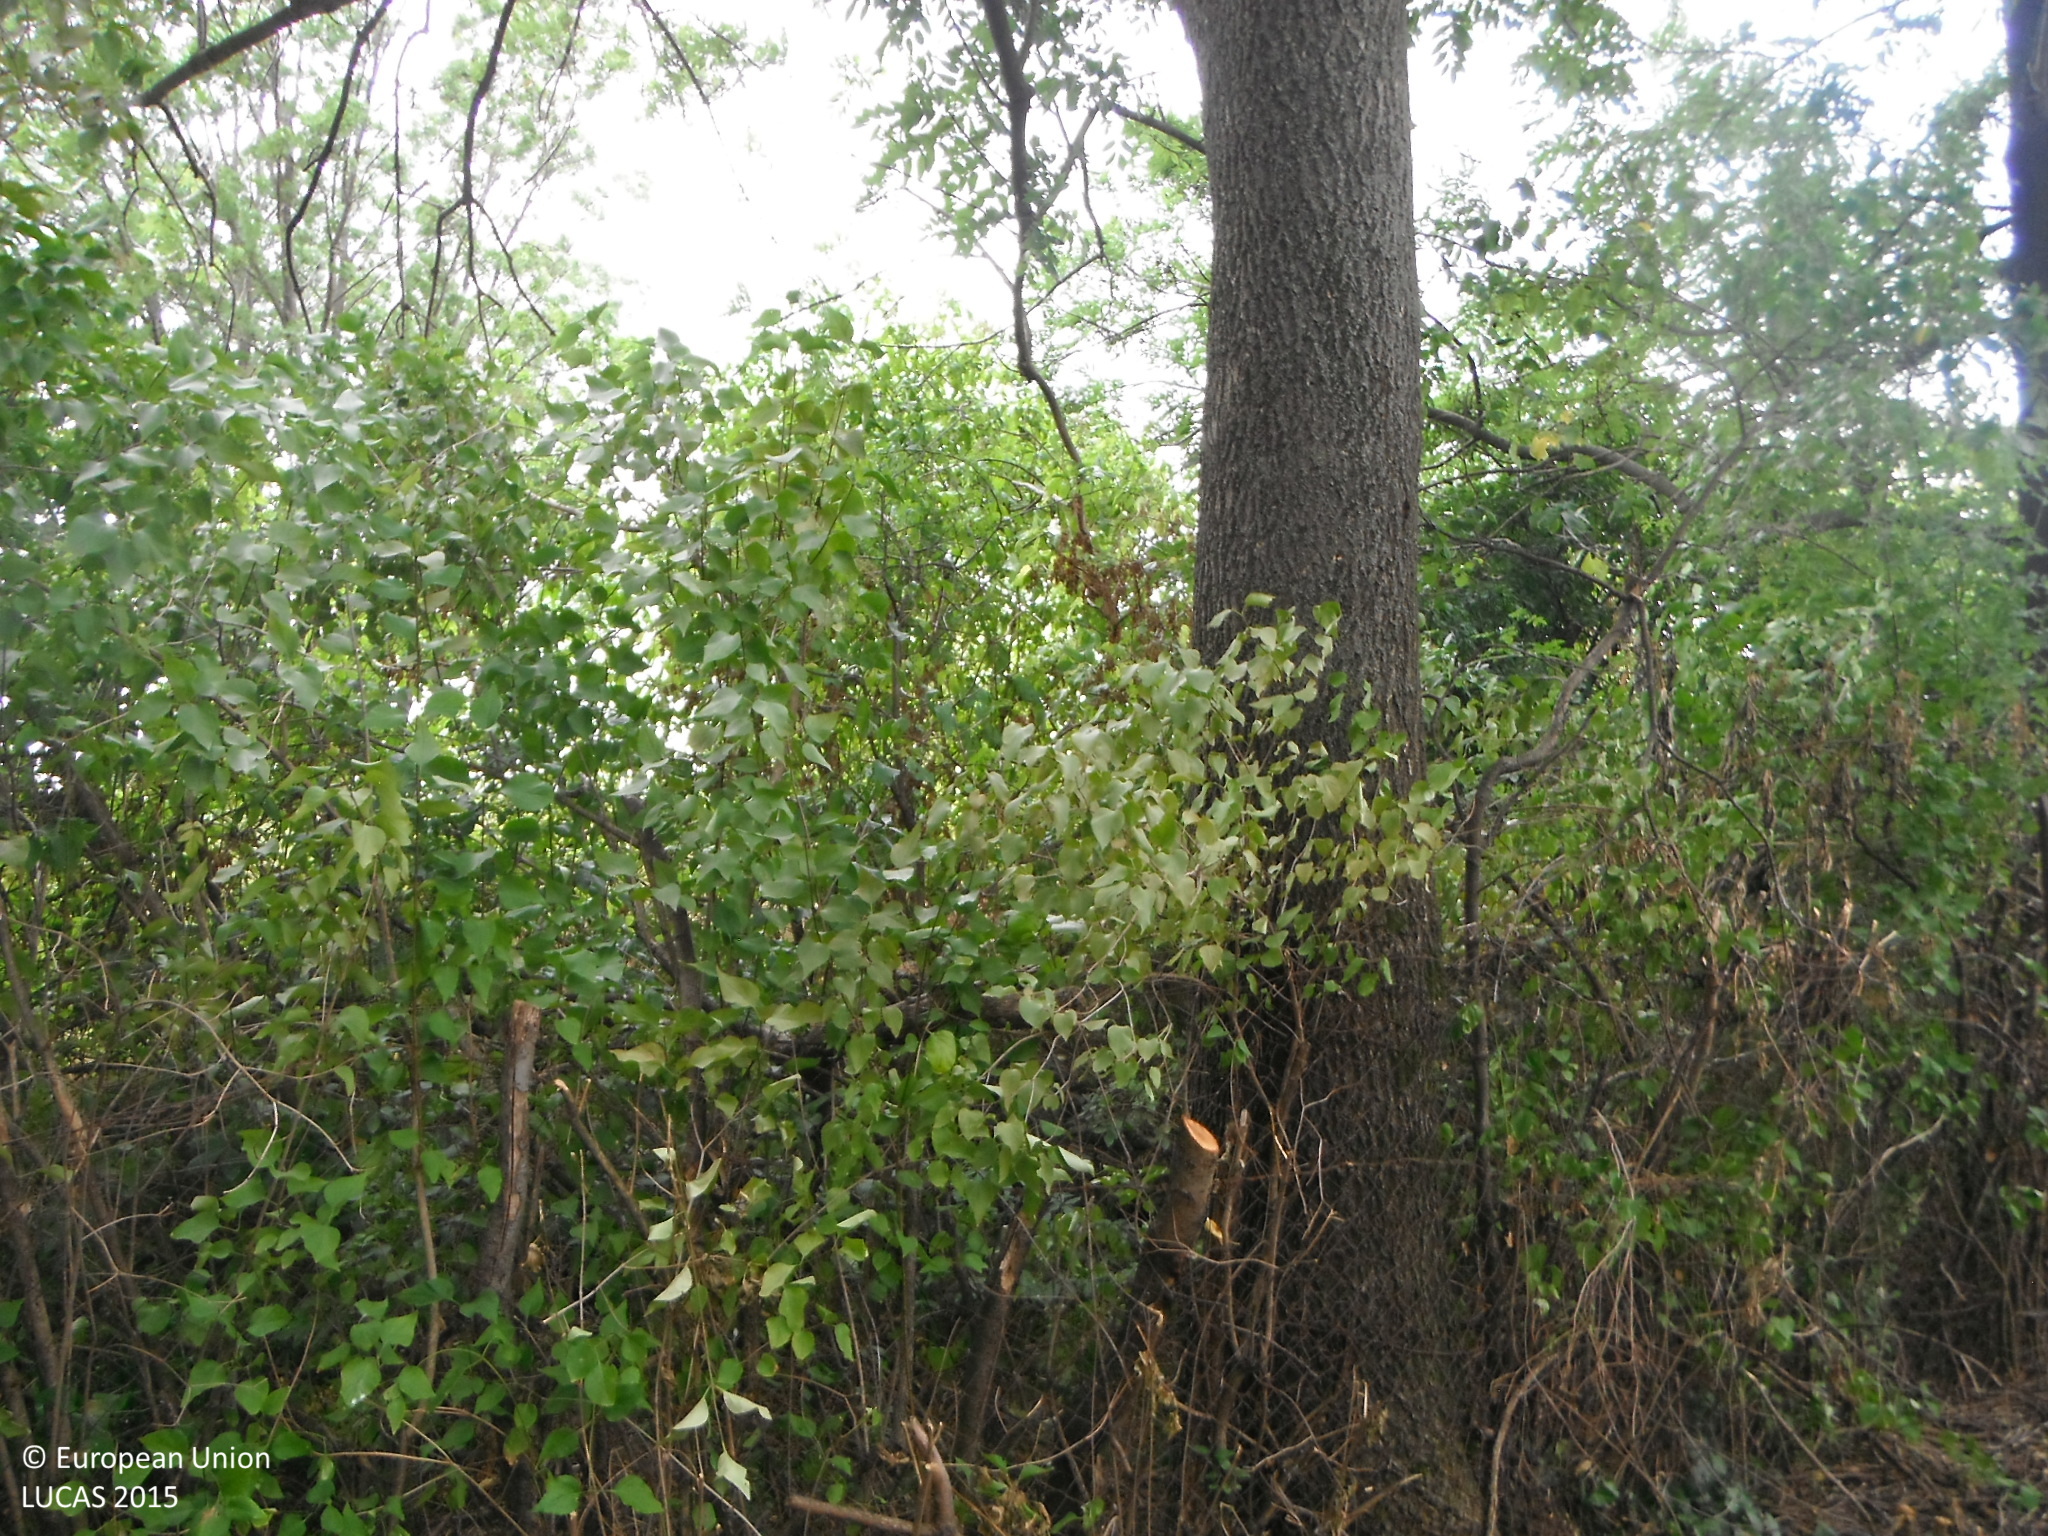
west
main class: Cropland
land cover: Other fruit trees and berries
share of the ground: 10 - 25 %
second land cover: Grassland without tree/shrub cover
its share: > 75 %
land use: Kitchen garden
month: July
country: SK
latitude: 48.4844
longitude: 18.1184
